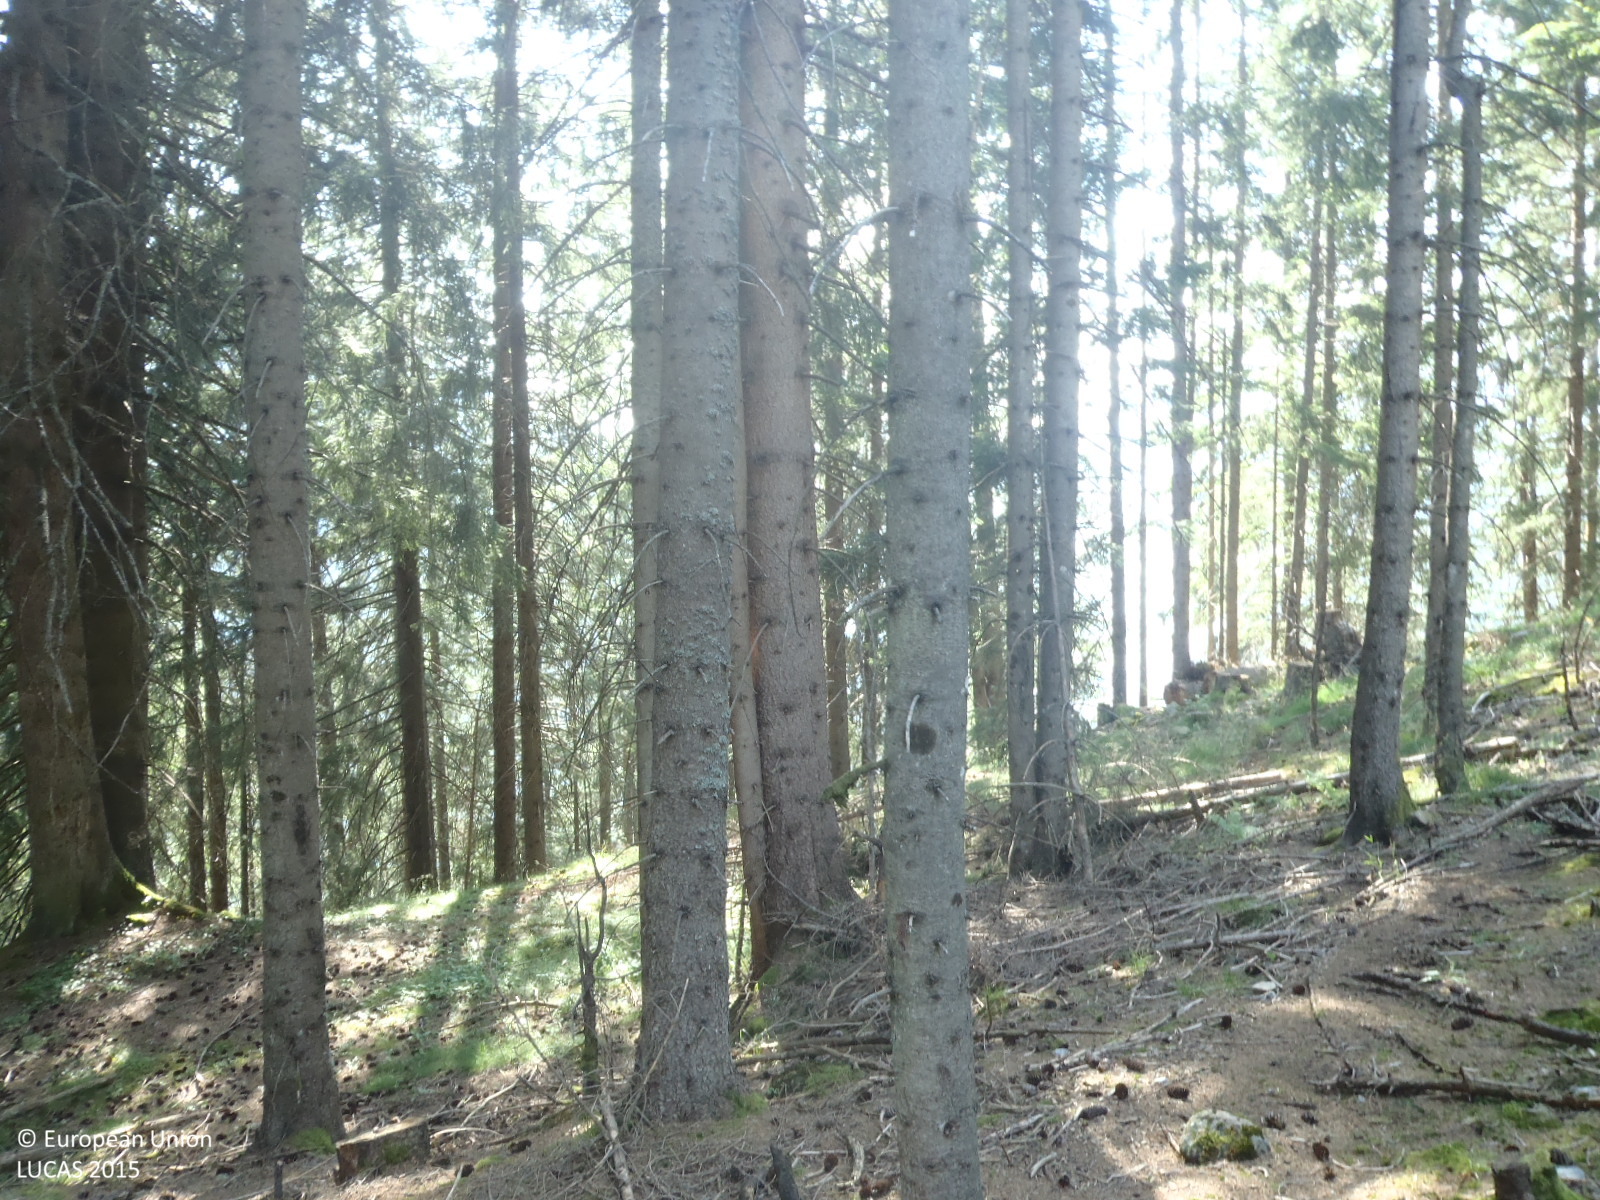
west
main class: Woodland
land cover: Spruce dominated coniferous woodland
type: alpine coniferous forest
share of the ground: > 75 %
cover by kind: coniferous forest trees 100 %
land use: Forestry
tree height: > 5 m
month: July
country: AT
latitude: 47.0895
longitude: 10.0132
